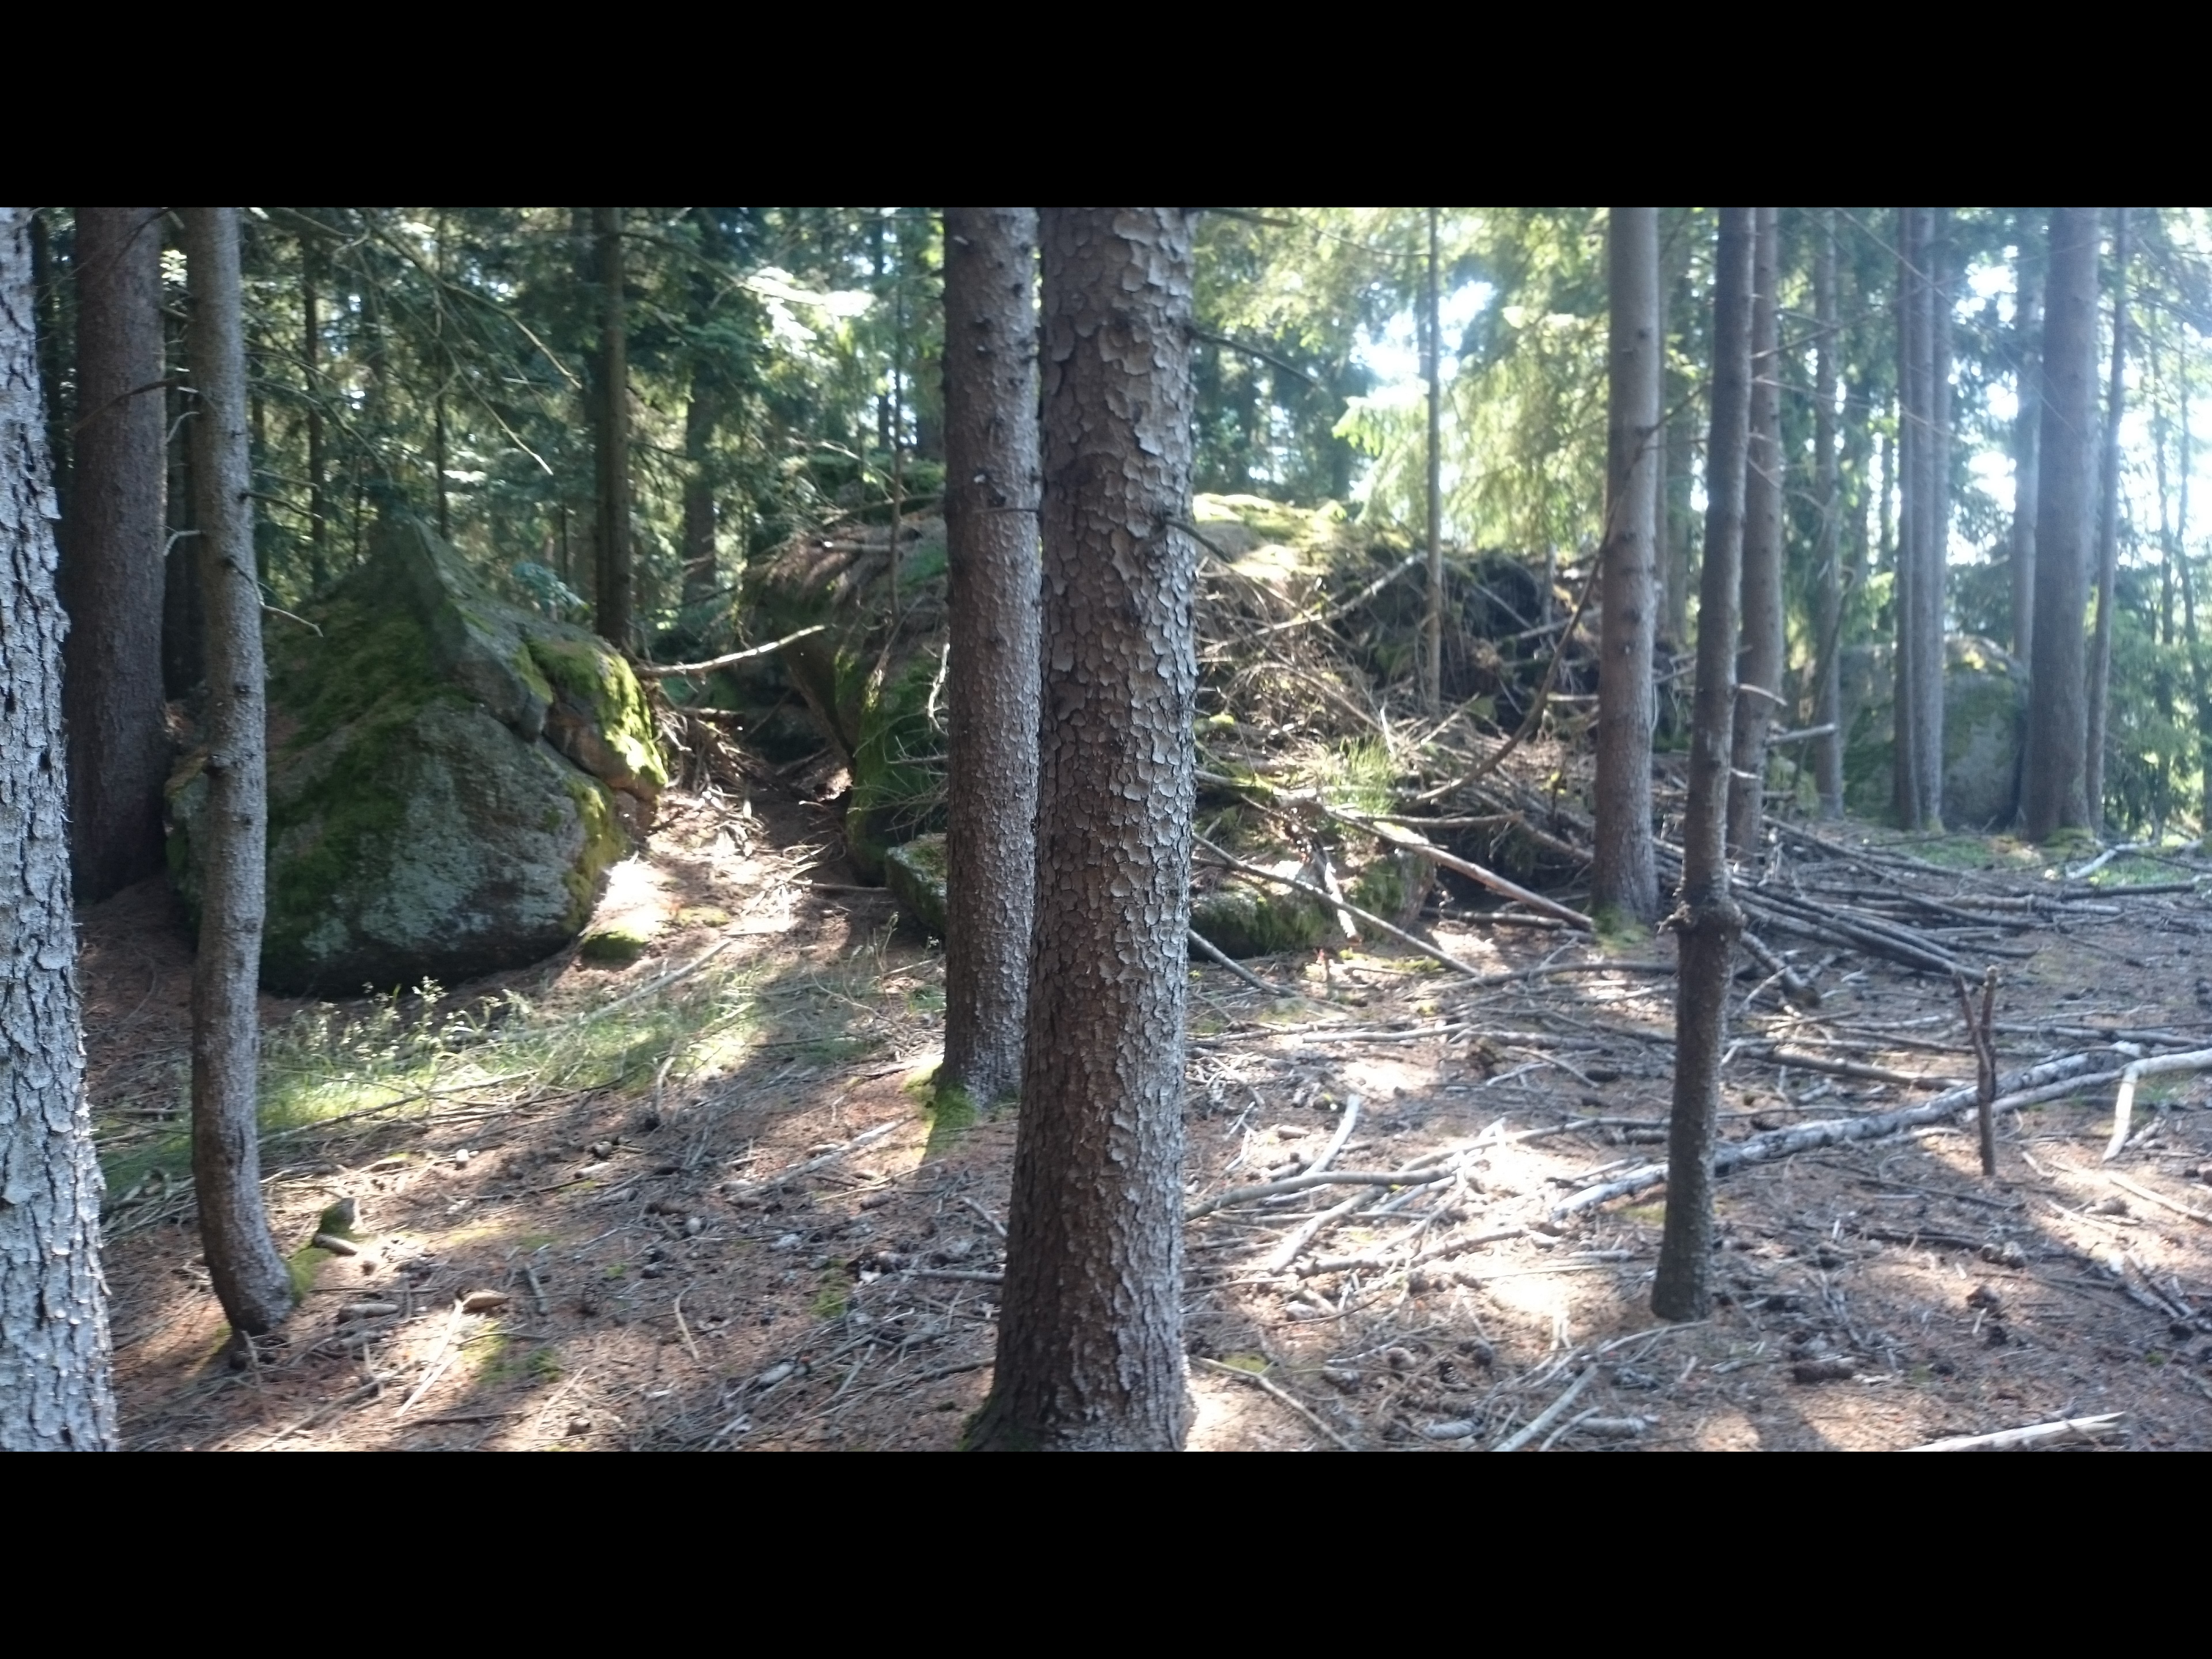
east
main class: Woodland
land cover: Spruce dominated coniferous woodland
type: hemiboreal forest and nemoral coniferous forest and mixed broadleaved-coniferous forest
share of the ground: > 75 %
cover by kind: coniferous forest trees 75 %, unconsolidated bare surface 20 %, shrubs 5 %
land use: Forestry
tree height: > 5 m
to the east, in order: Spruce dominated coniferous woodland; Tracks; Spruce dominated mixed woodland; Rivers and streams; Spruce dominated mixed woodland
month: June
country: AT
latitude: 48.4504
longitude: 14.6384
